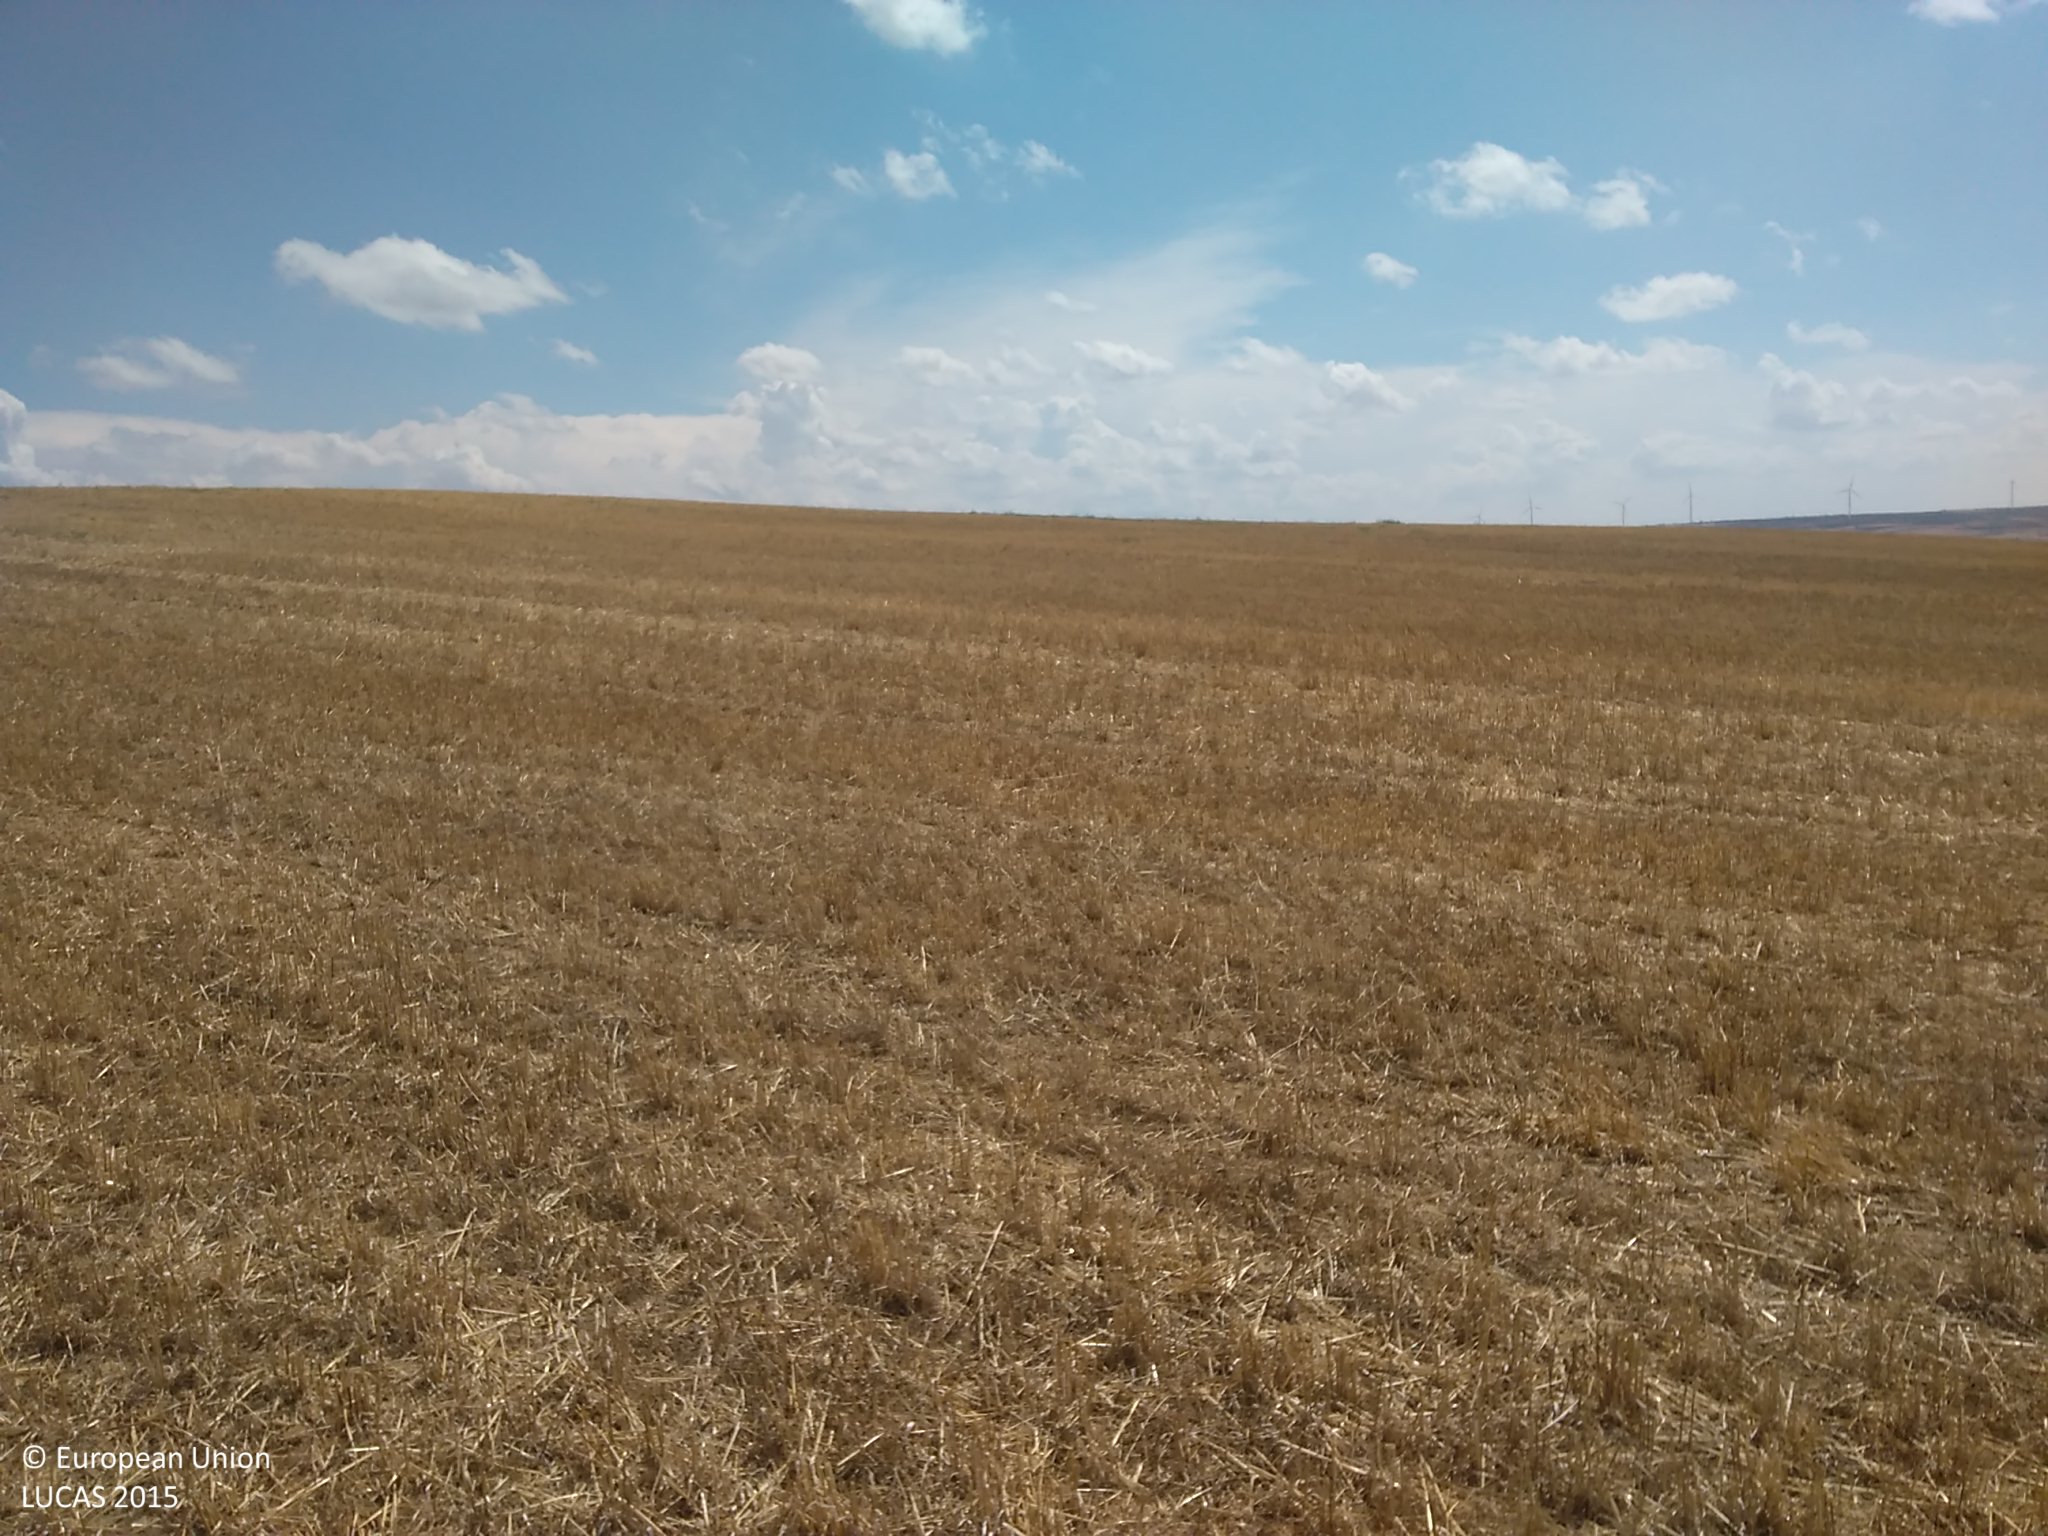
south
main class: Cropland
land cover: Barley
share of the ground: < 10 %
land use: Agriculture (excluding fallow land and kitchen gardens)
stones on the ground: < 10 %
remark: Harvested field
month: July
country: ES
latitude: 41.6019
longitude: -2.2117
